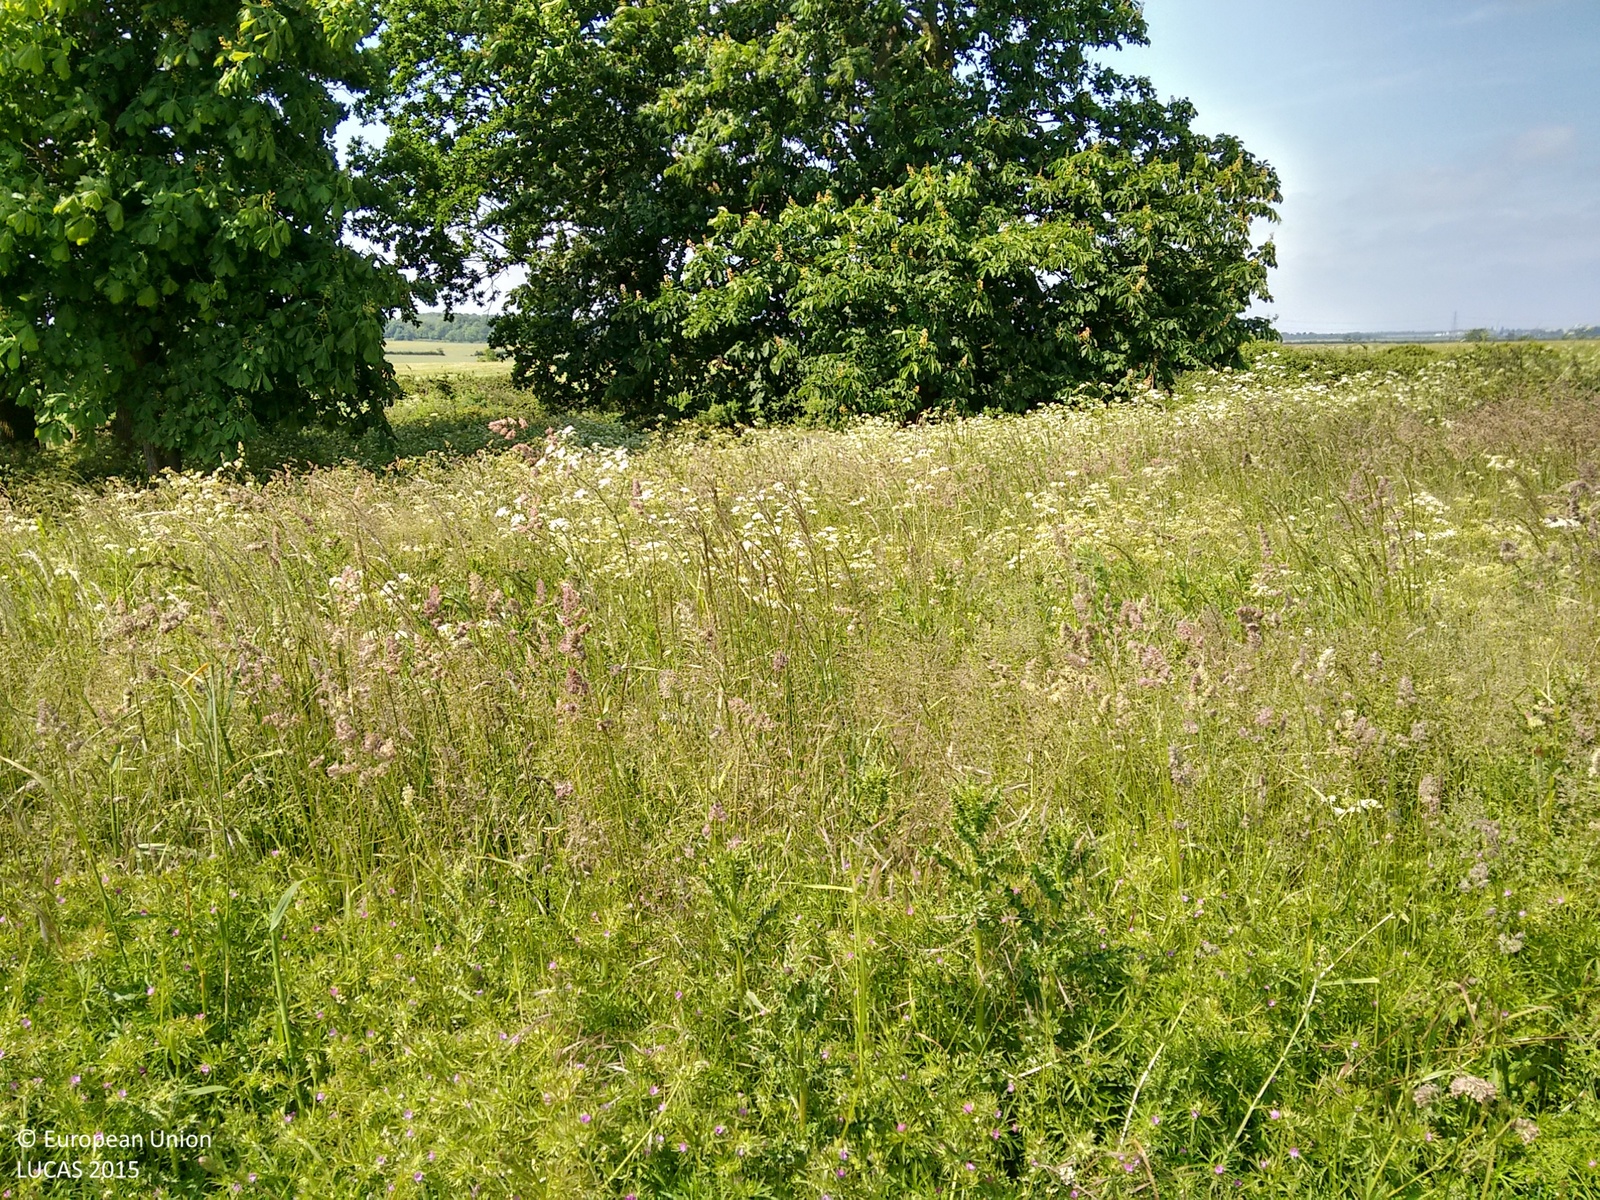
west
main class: Grassland
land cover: Spontaneously vegetated surfaces
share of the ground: > 75 %
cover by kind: herbaceous plants 100 %
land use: Agriculture (excluding fallow land and kitchen gardens)
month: June
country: GB
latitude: 52.9614
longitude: -0.7145
